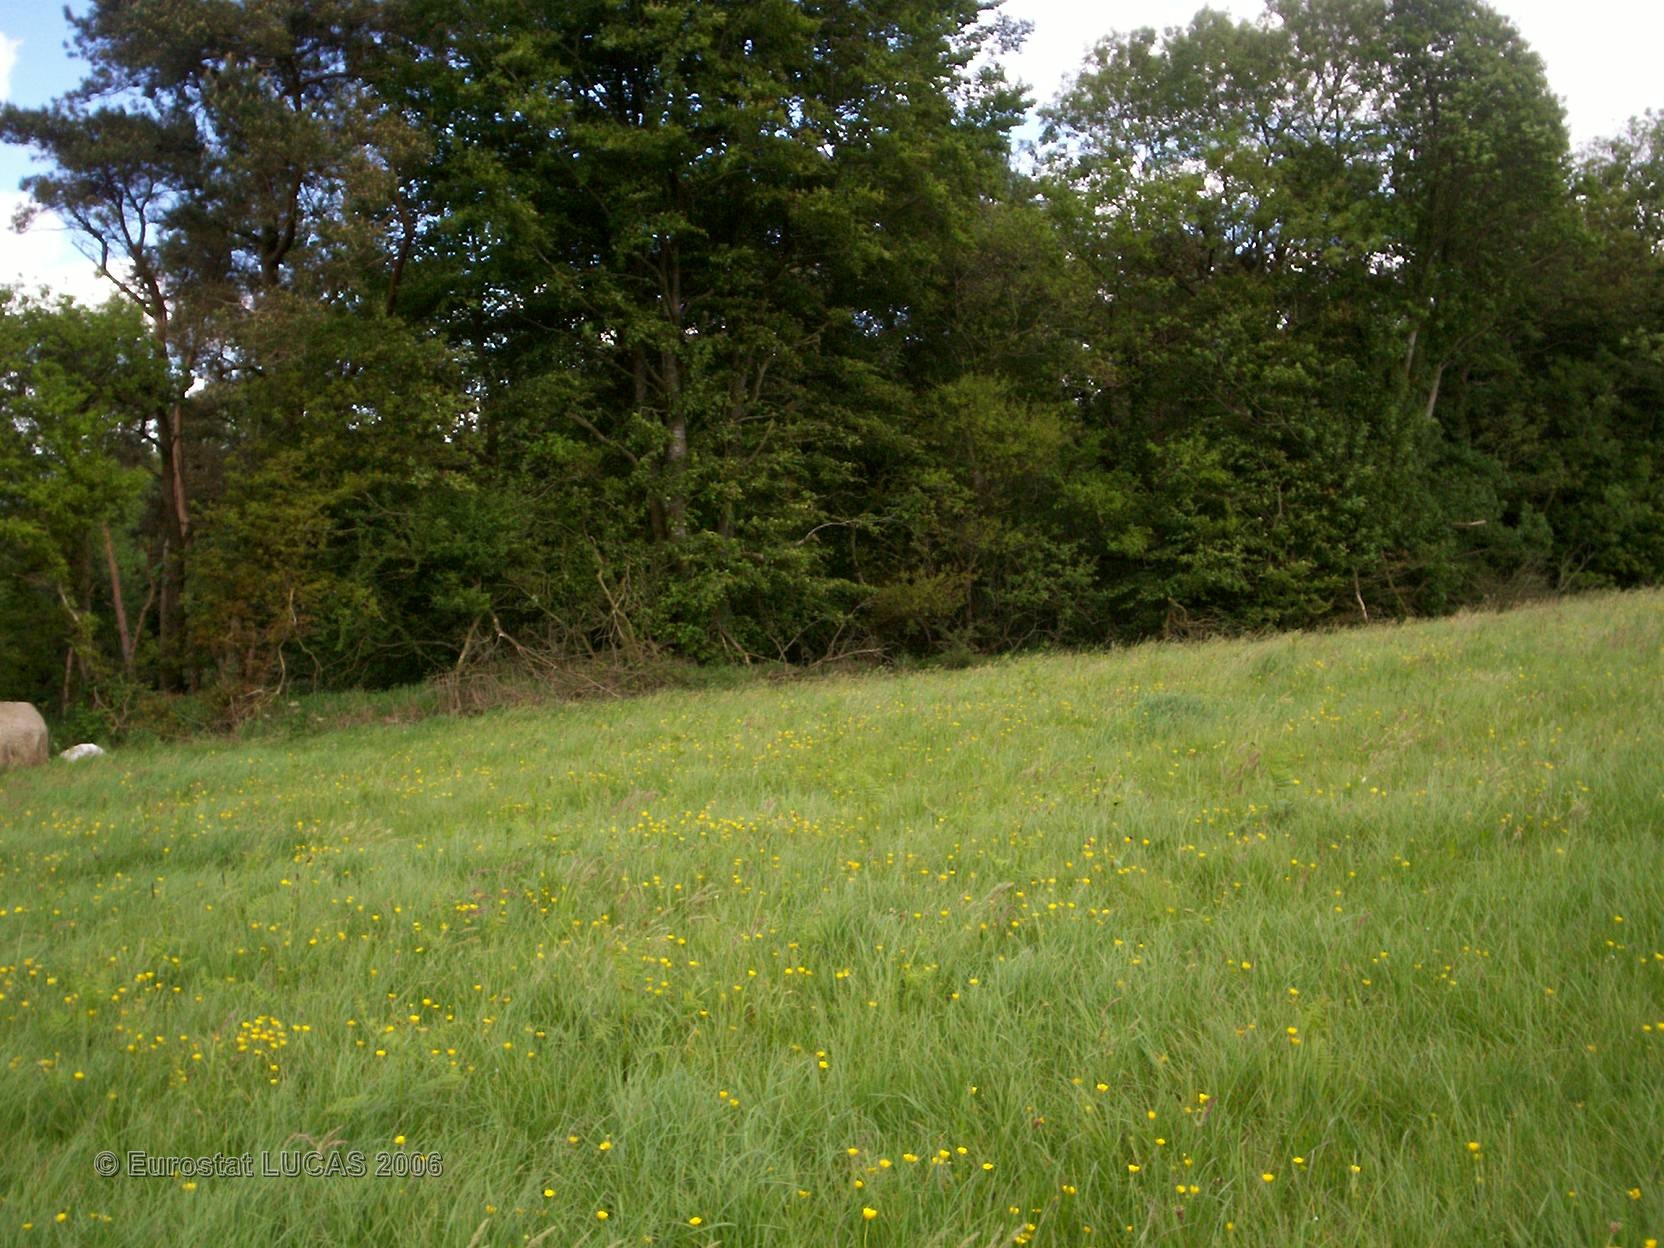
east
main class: Grassland
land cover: Grassland without tree/shrub cover
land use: Agriculture (excluding fallow land and kitchen gardens)
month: May
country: FR
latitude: 48.4125
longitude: -3.0266
